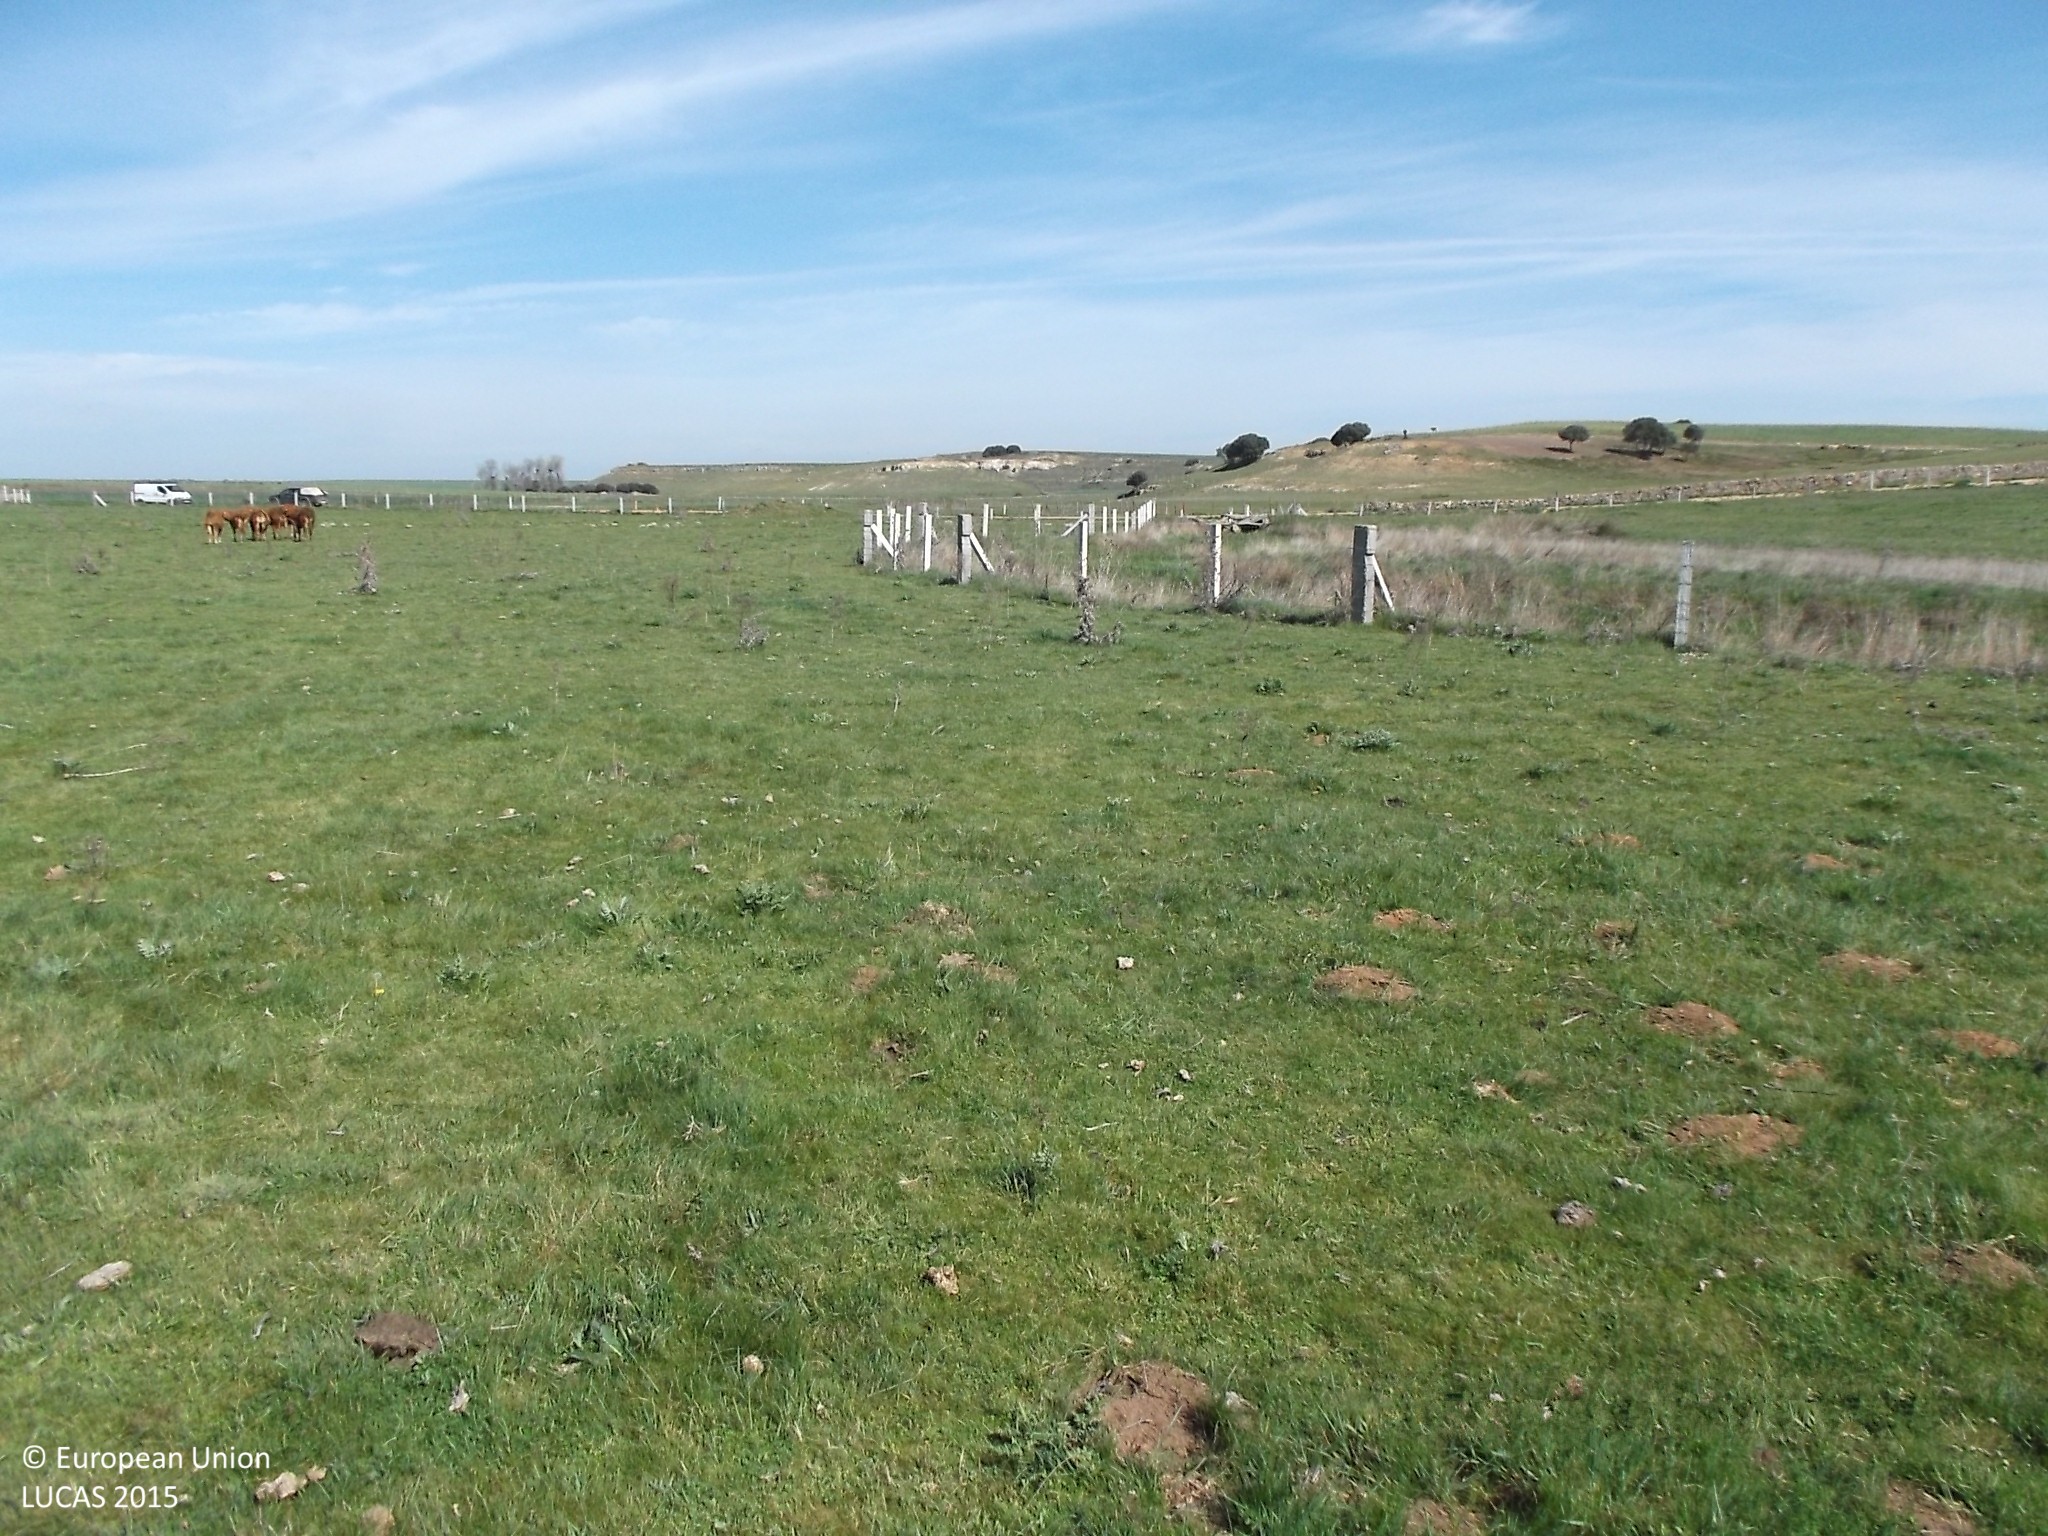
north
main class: Grassland
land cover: Grassland without tree/shrub cover
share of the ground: > 75 %
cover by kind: herbaceous plants 100 %
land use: Agriculture (excluding fallow land and kitchen gardens)
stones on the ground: < 10 %
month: April
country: ES
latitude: 40.9664
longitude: -5.8975
